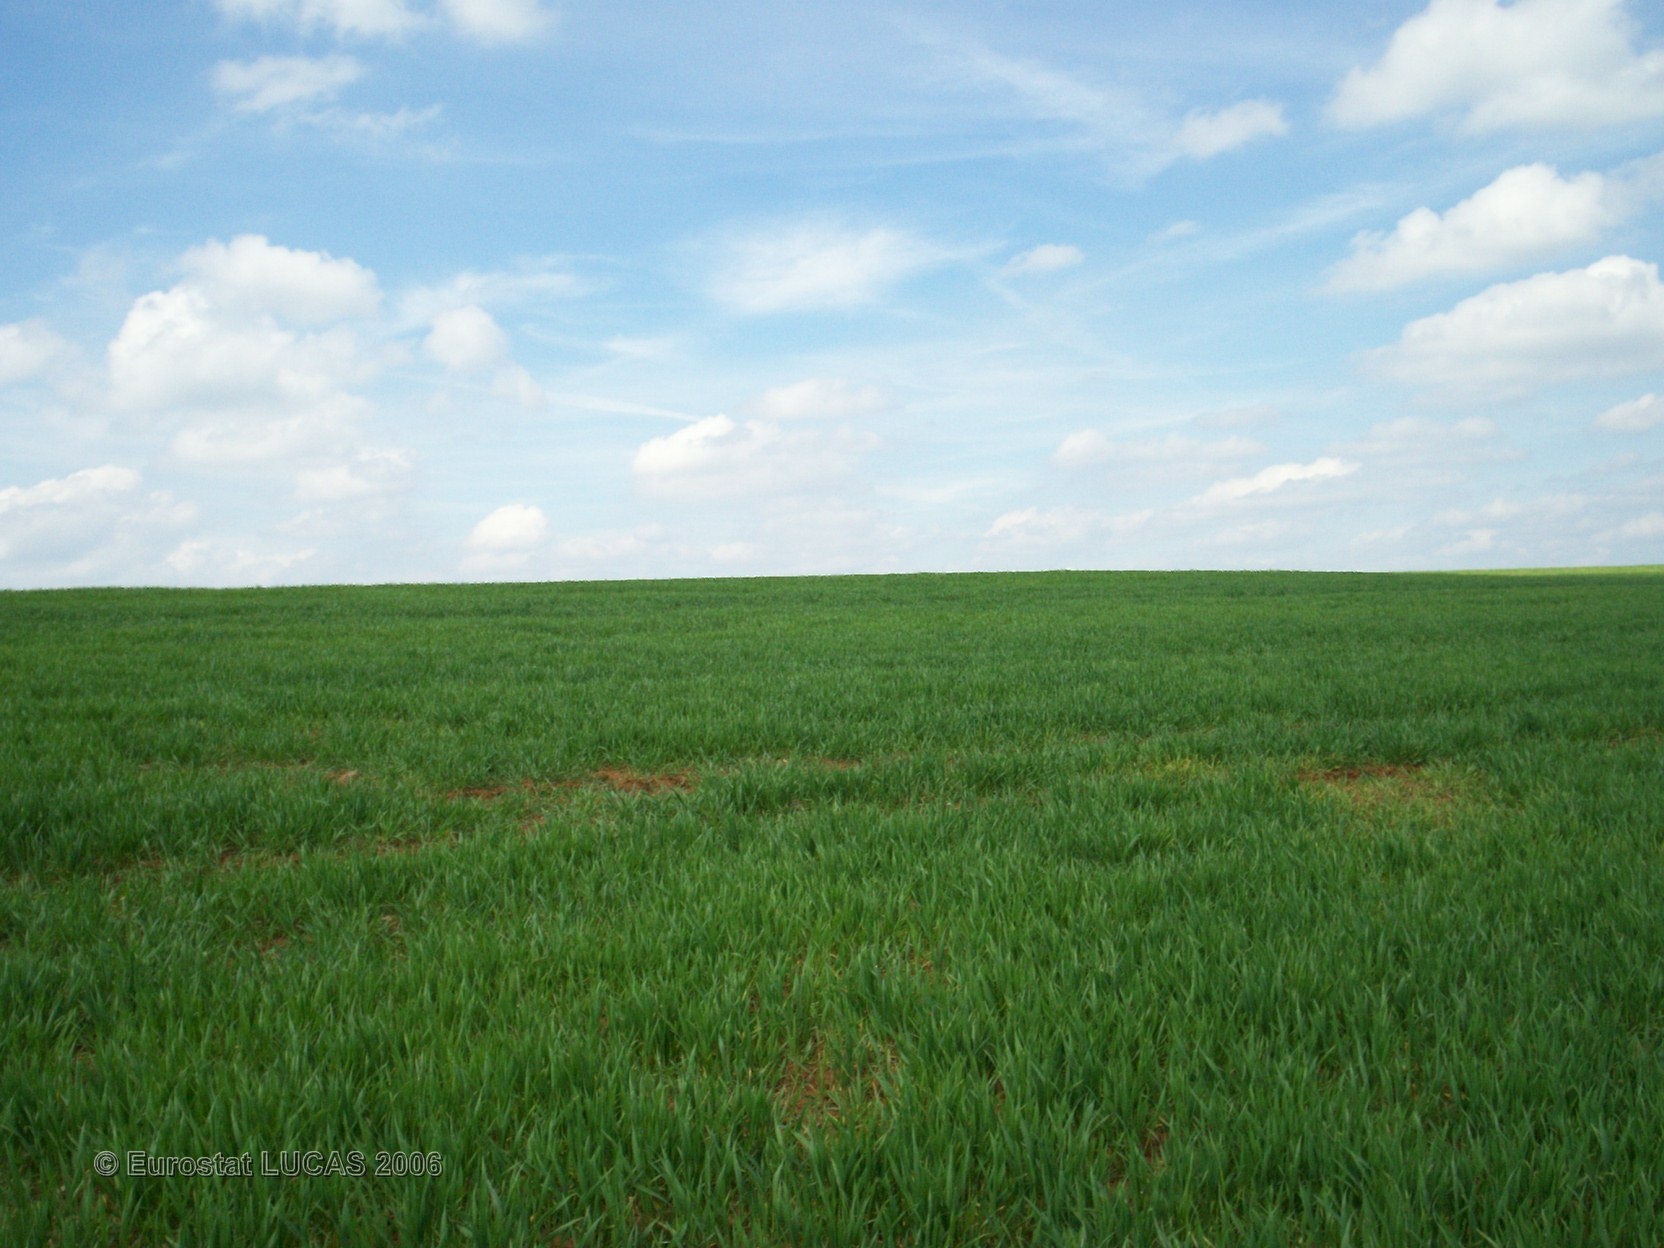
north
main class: Cropland
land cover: Common wheat
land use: Agriculture (excluding fallow land and kitchen gardens)
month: May
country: FR
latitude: 49.8107
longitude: 4.3676
